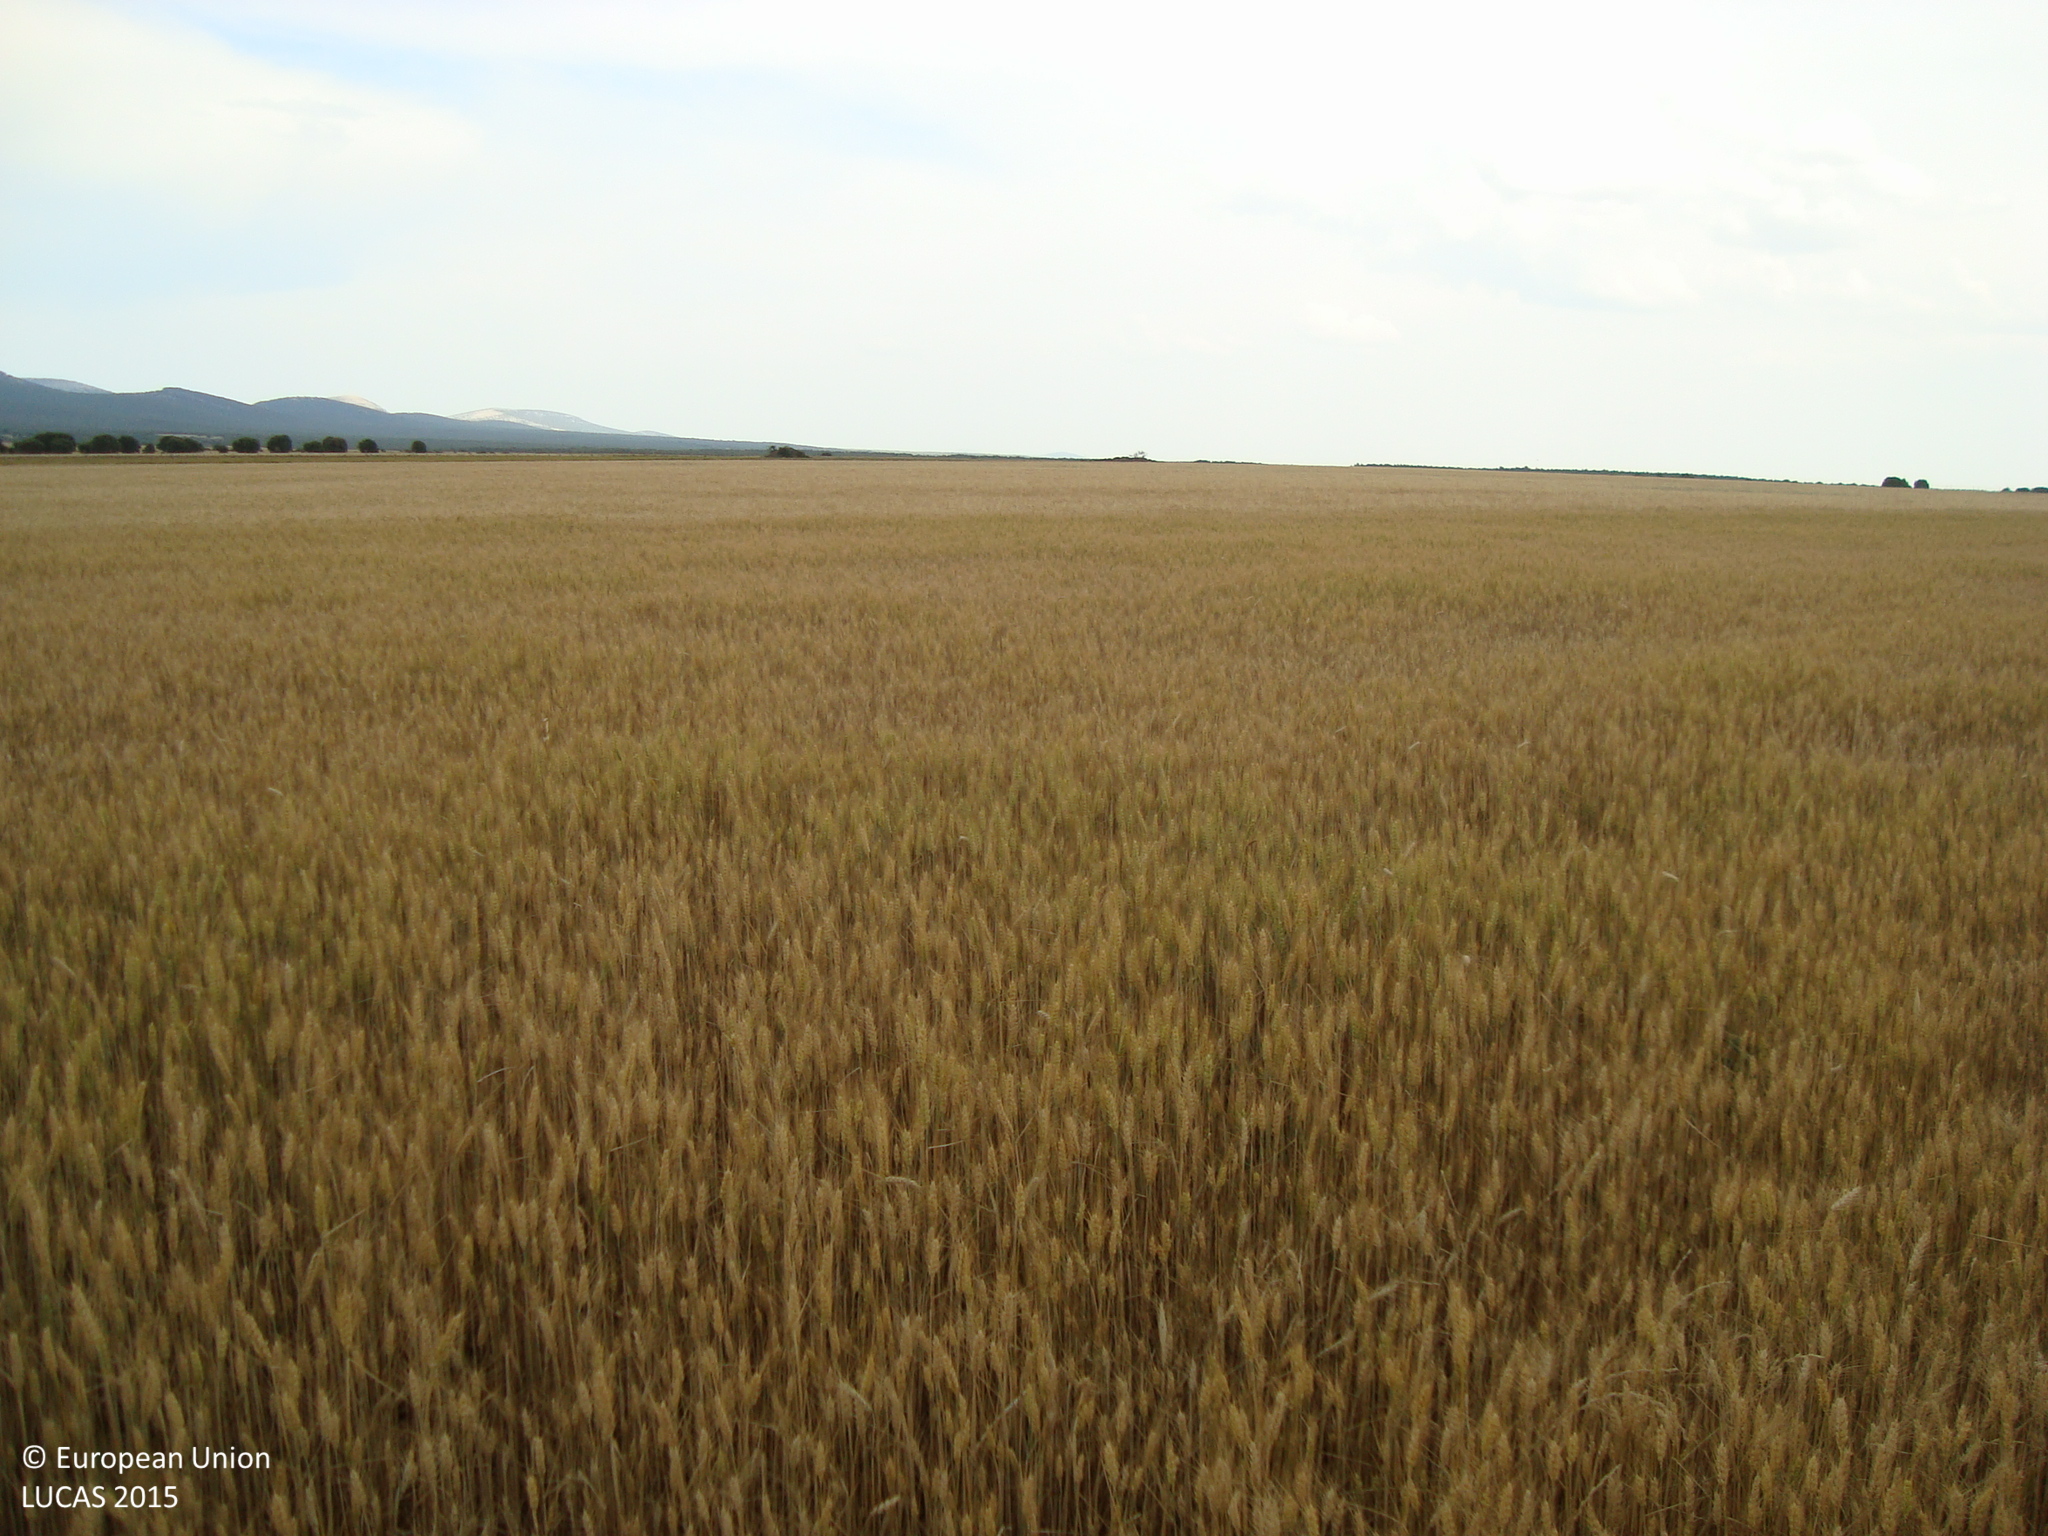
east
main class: Cropland
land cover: Common wheat
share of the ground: > 75 %
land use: Agriculture (excluding fallow land and kitchen gardens)
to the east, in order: Common wheat
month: June
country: ES
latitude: 41.9269
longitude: -3.6456
